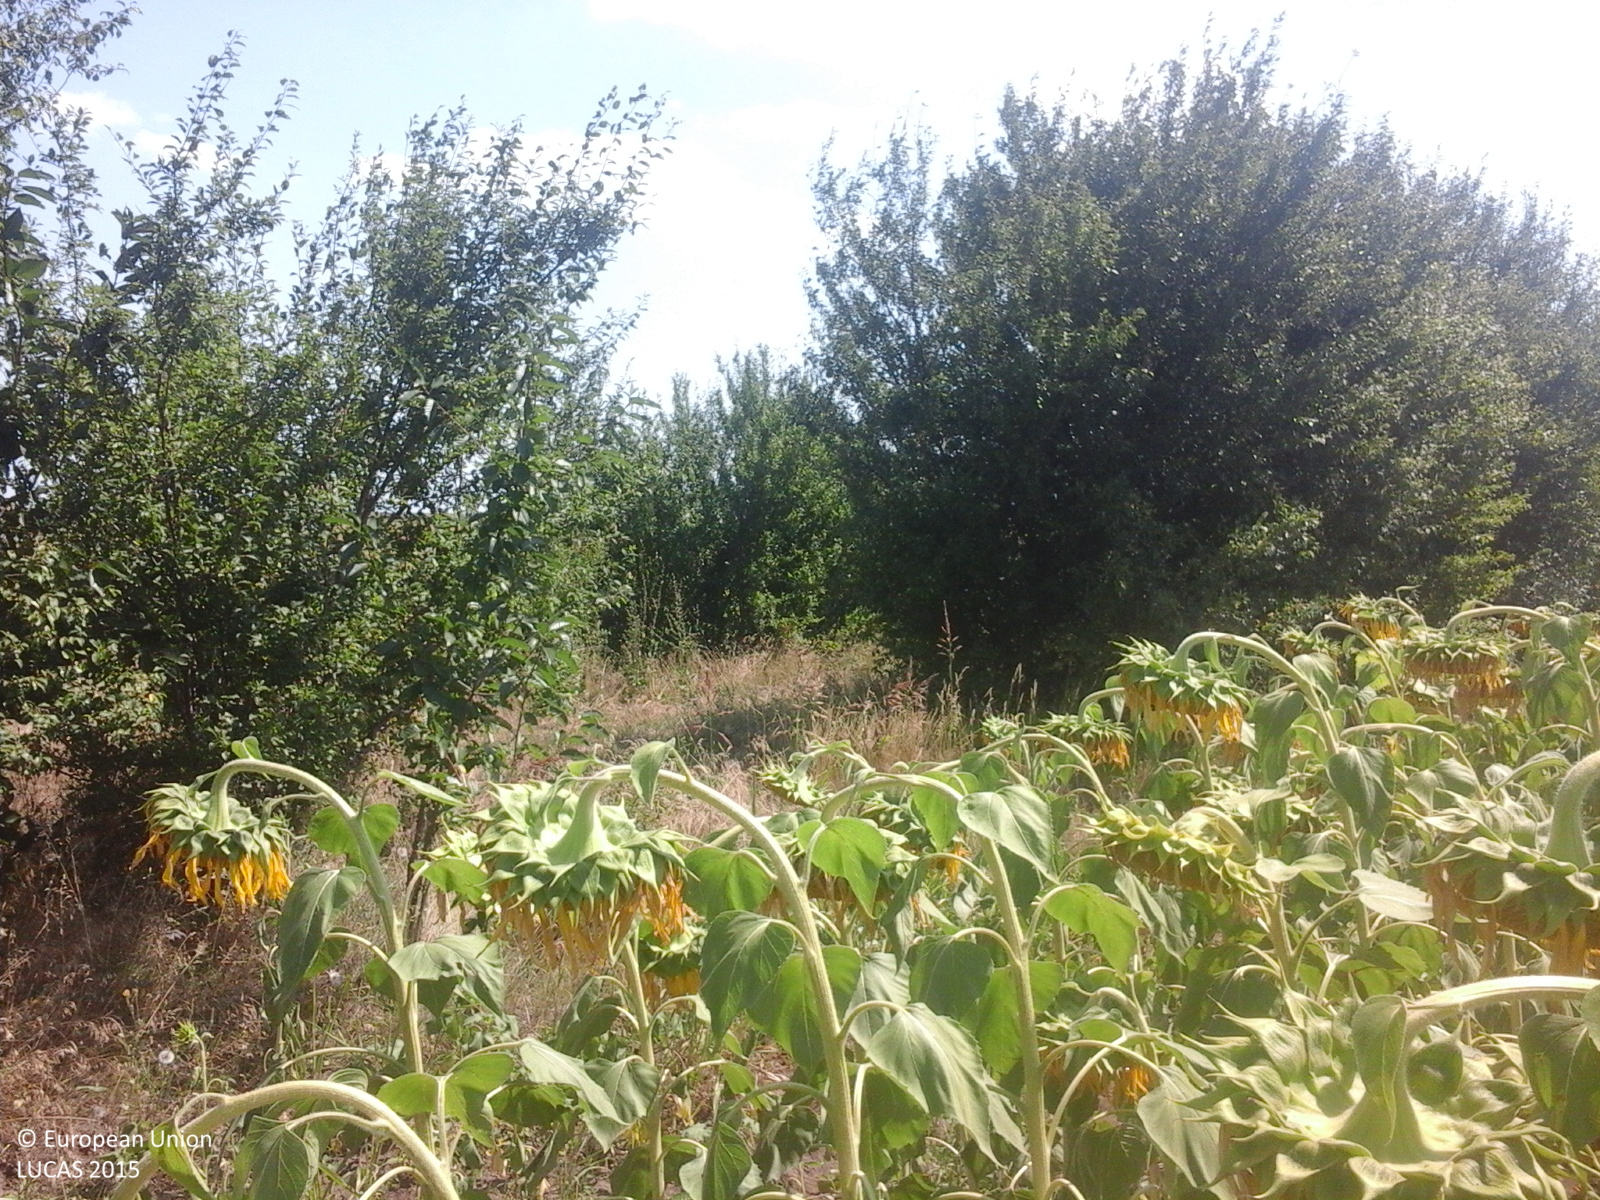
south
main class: Cropland
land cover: Sunflower
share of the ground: > 75 %
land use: Agriculture (excluding fallow land and kitchen gardens)
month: July
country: RO
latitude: 45.0080
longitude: 26.8133
